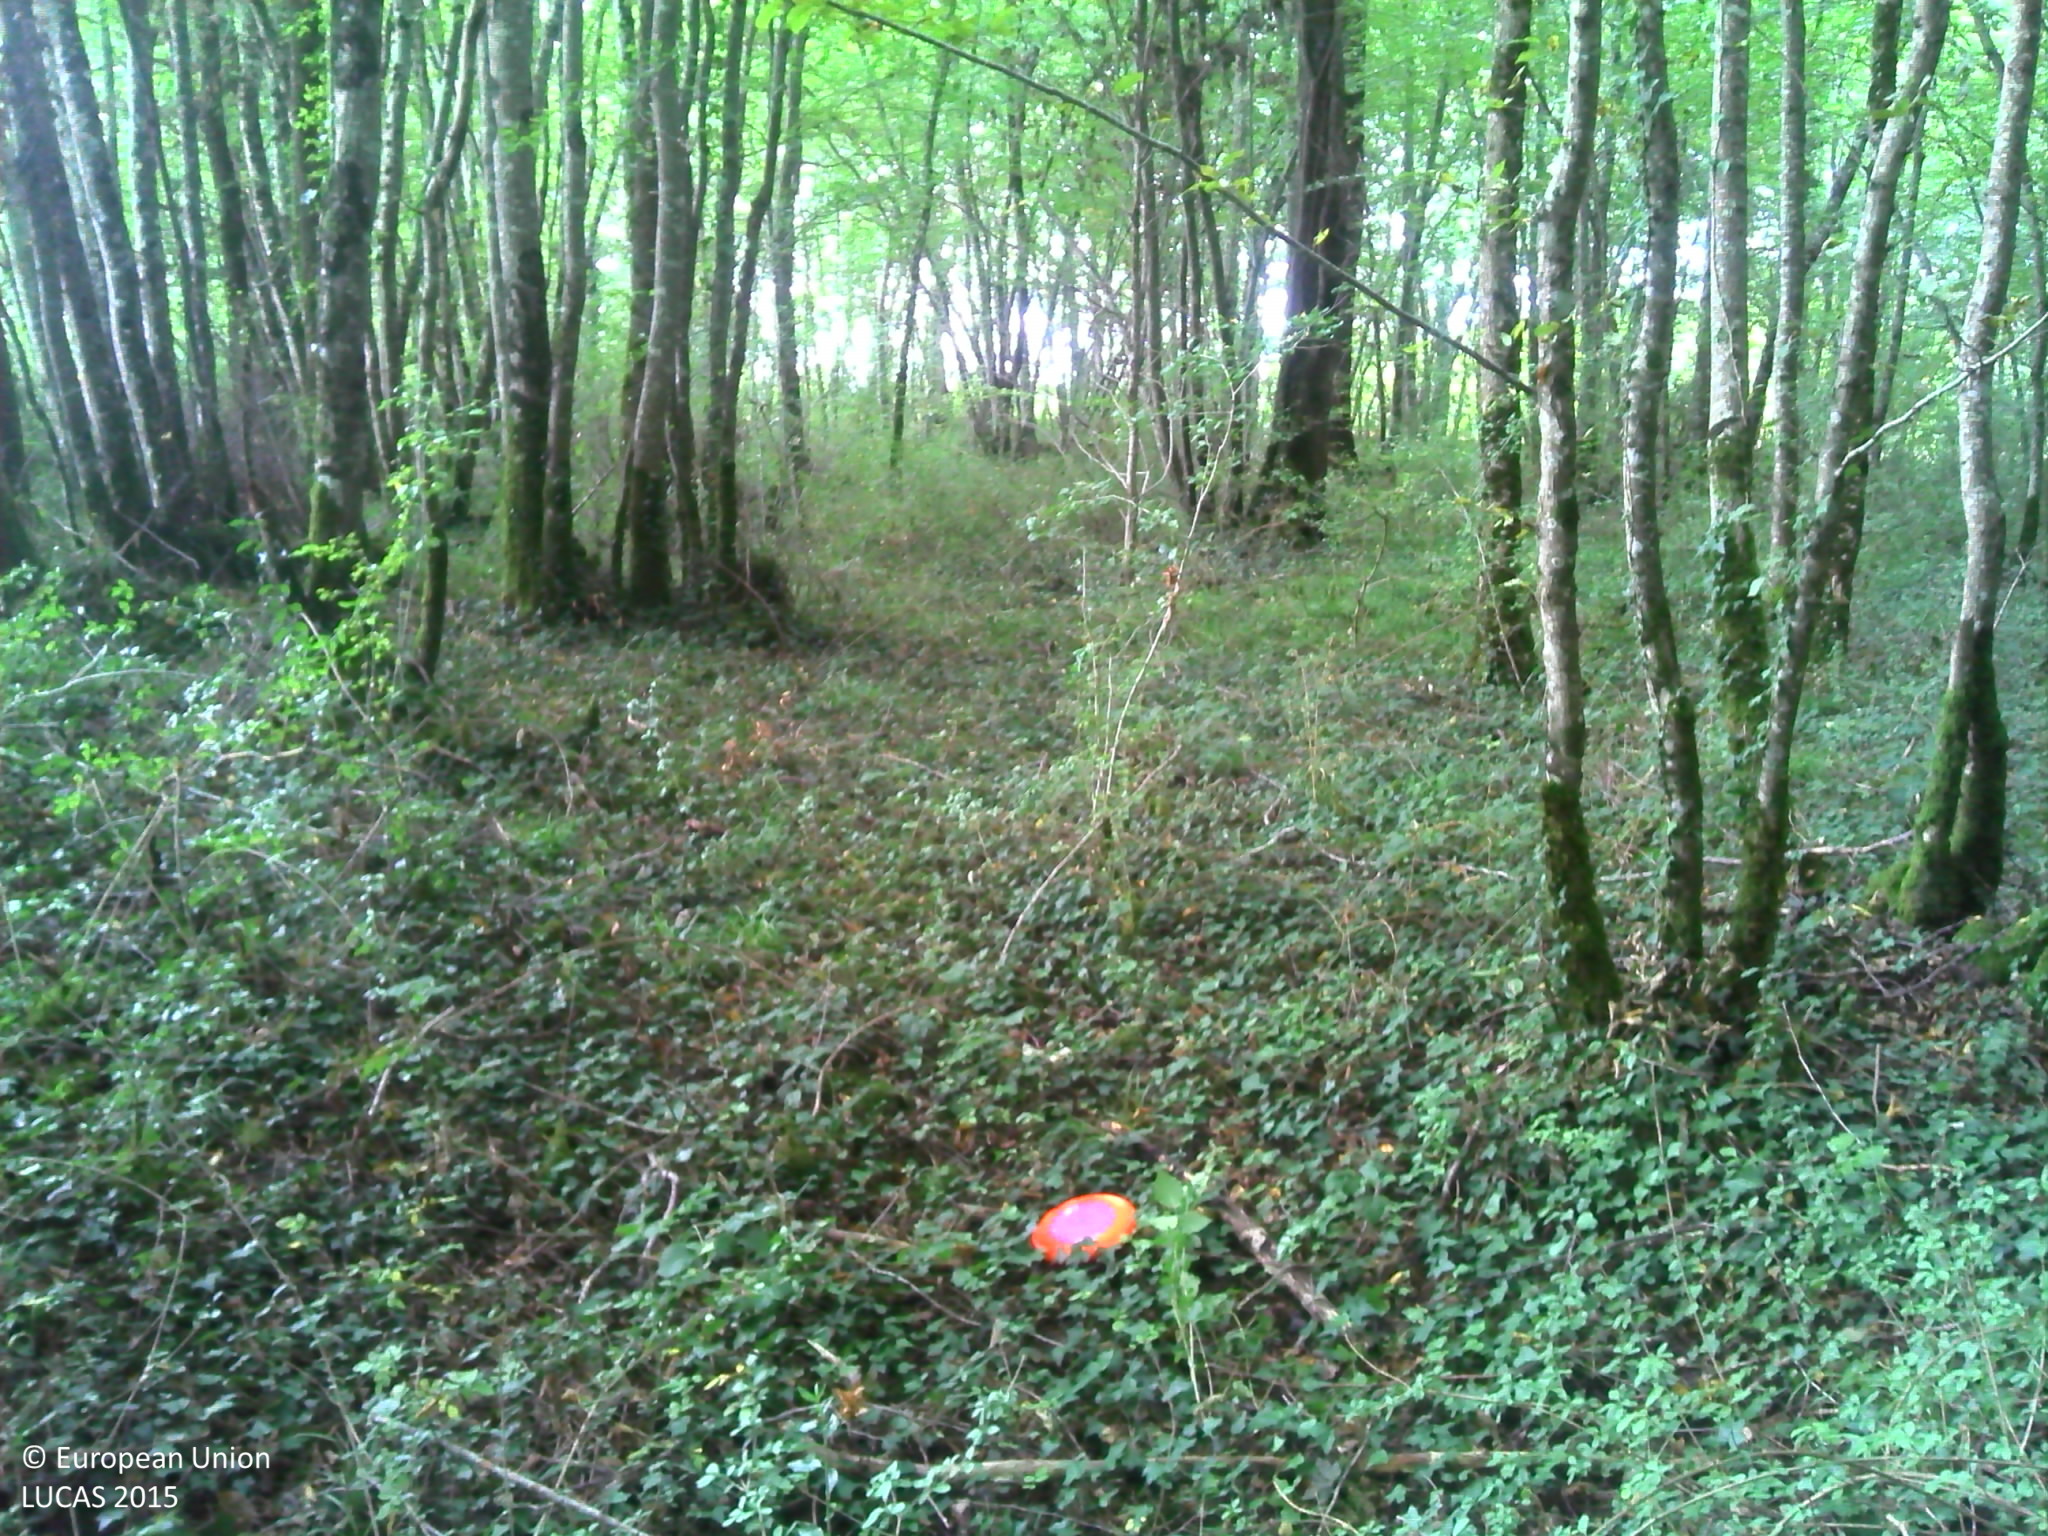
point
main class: Woodland
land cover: Broadleaved woodland
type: mesophytic deciduous forest
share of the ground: > 75 %
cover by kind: broadleaved forest trees 95 %, herbaceous plants 5 %
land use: Forestry
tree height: > 5 m
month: September
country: FR
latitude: 46.7781
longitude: 1.5677
